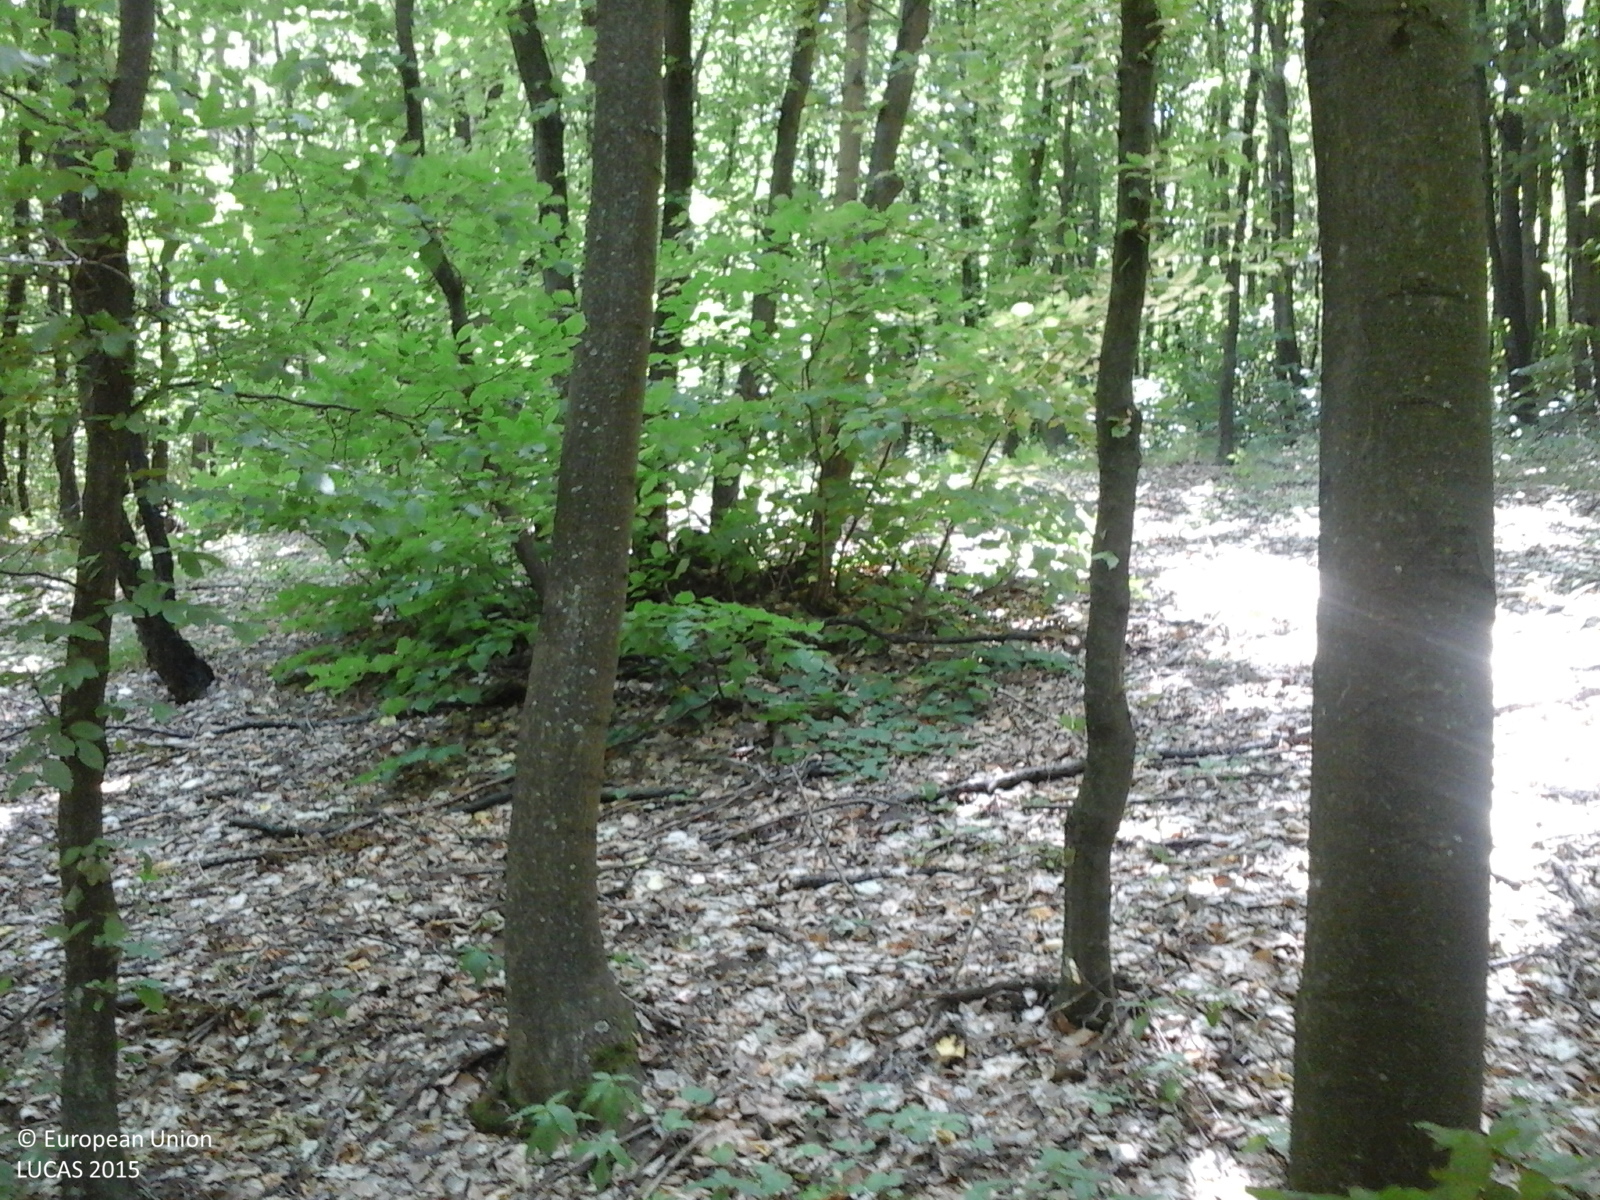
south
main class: Woodland
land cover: Broadleaved woodland
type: beech forest
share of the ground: > 75 %
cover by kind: broadleaved forest trees 100 %
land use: Forestry
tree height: > 5 m
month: June
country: RO
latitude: 46.8315
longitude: 27.9168
